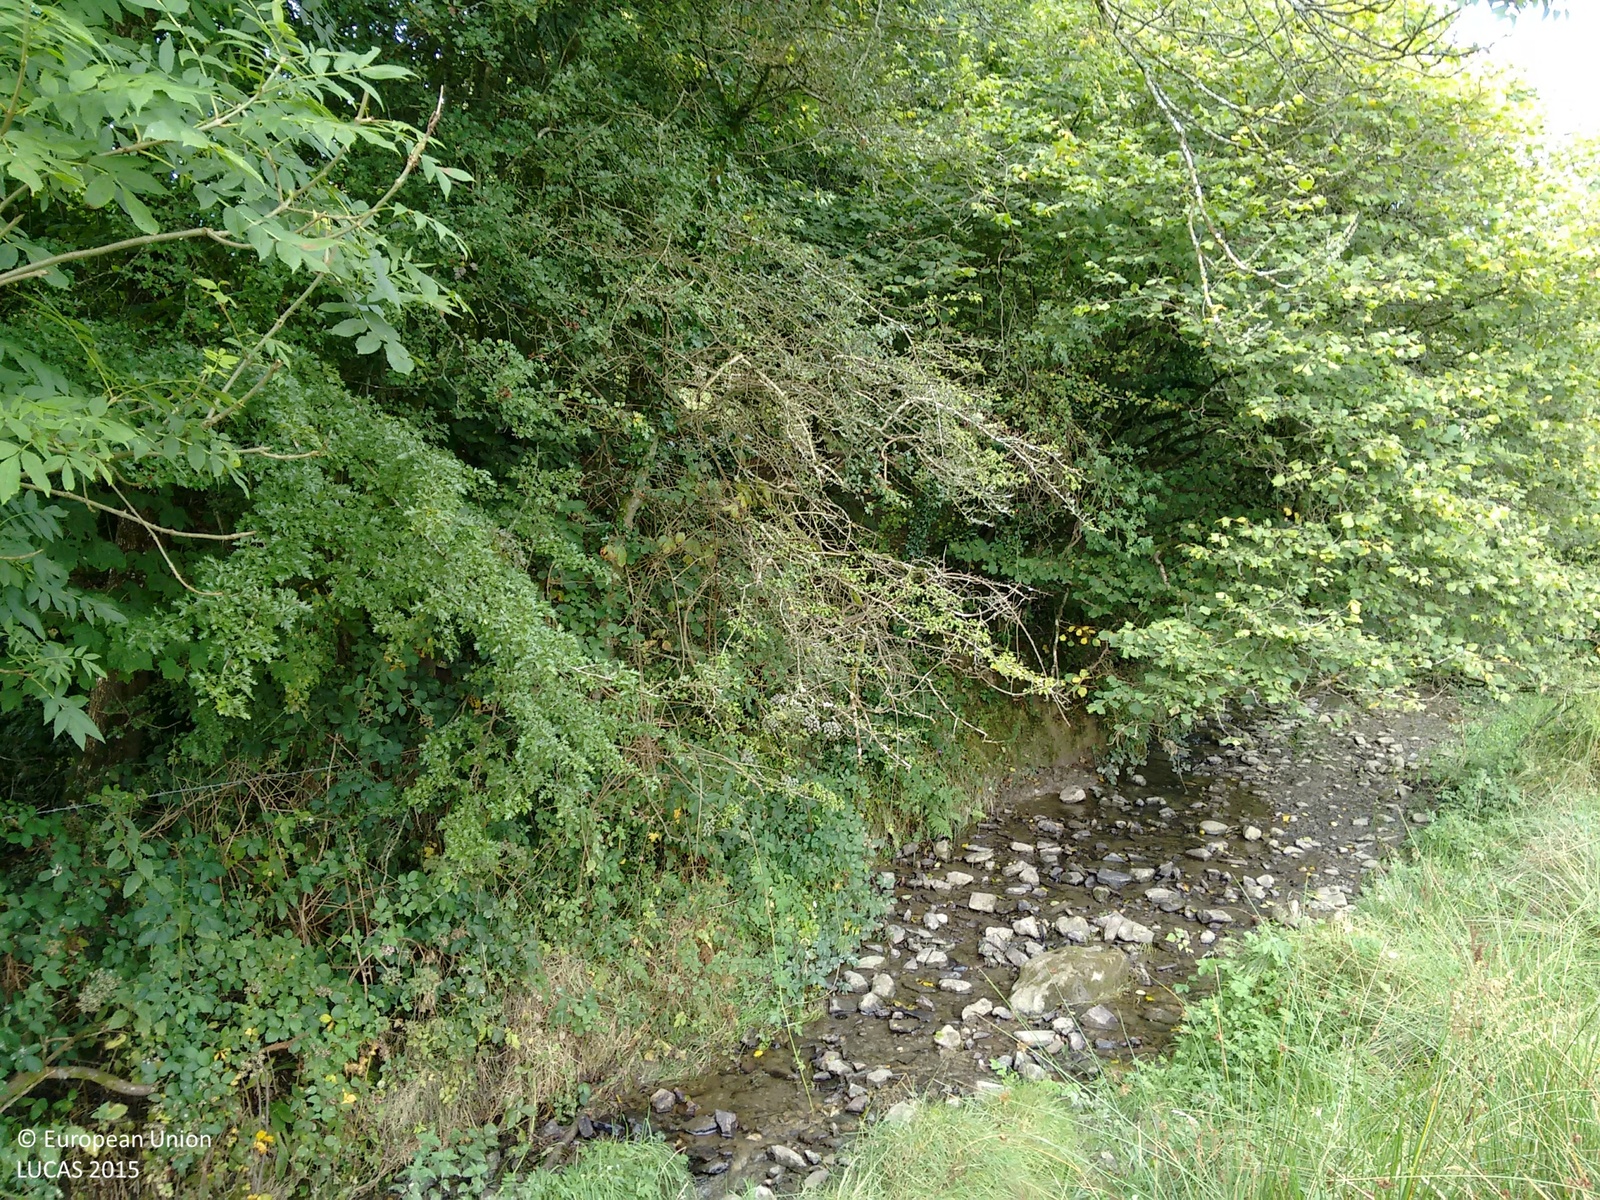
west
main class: Woodland
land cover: Broadleaved woodland
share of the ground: > 75 %
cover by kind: broadleaved forest trees 90 %, herbaceous plants 10 %
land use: Agriculture (excluding fallow land and kitchen gardens)
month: September
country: GB
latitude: 52.0653
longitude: -4.5030
